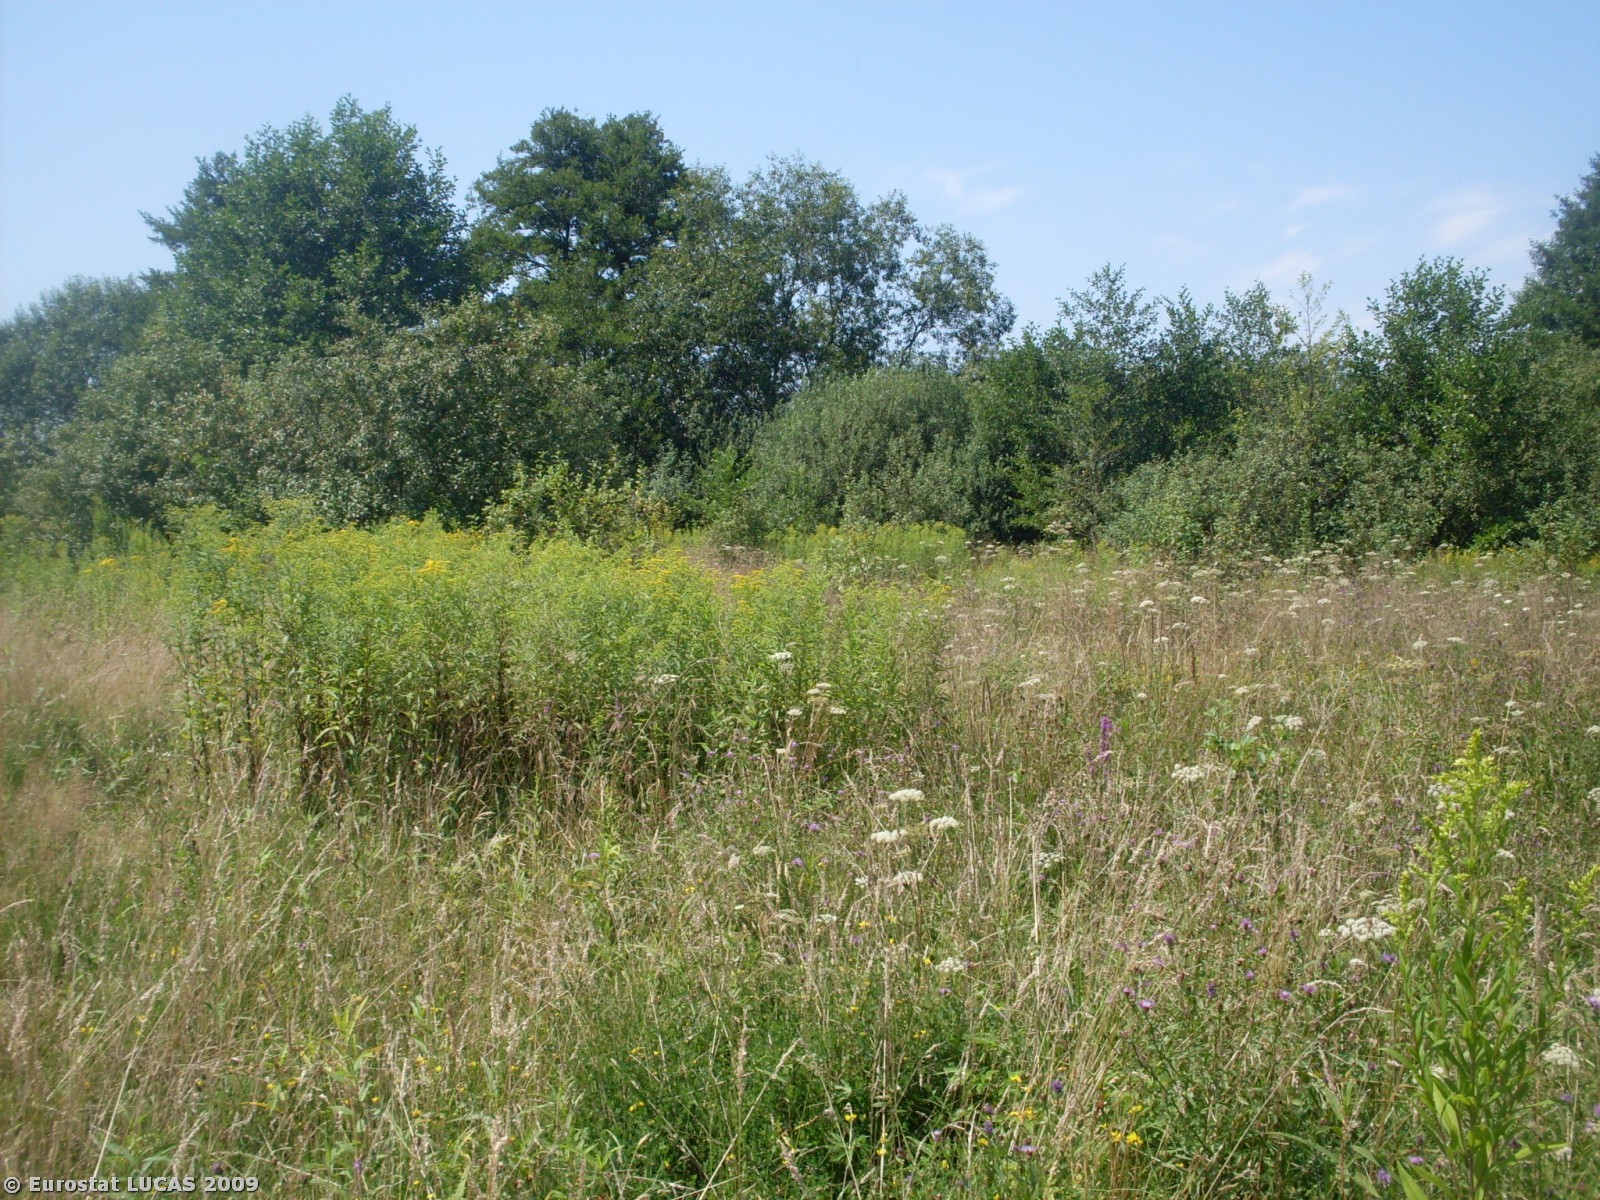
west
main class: Grassland
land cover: Grassland without tree/shrub cover
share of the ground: > 75 %
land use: Unused
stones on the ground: < 10 %
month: August
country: PL
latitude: 49.9971
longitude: 20.5991
